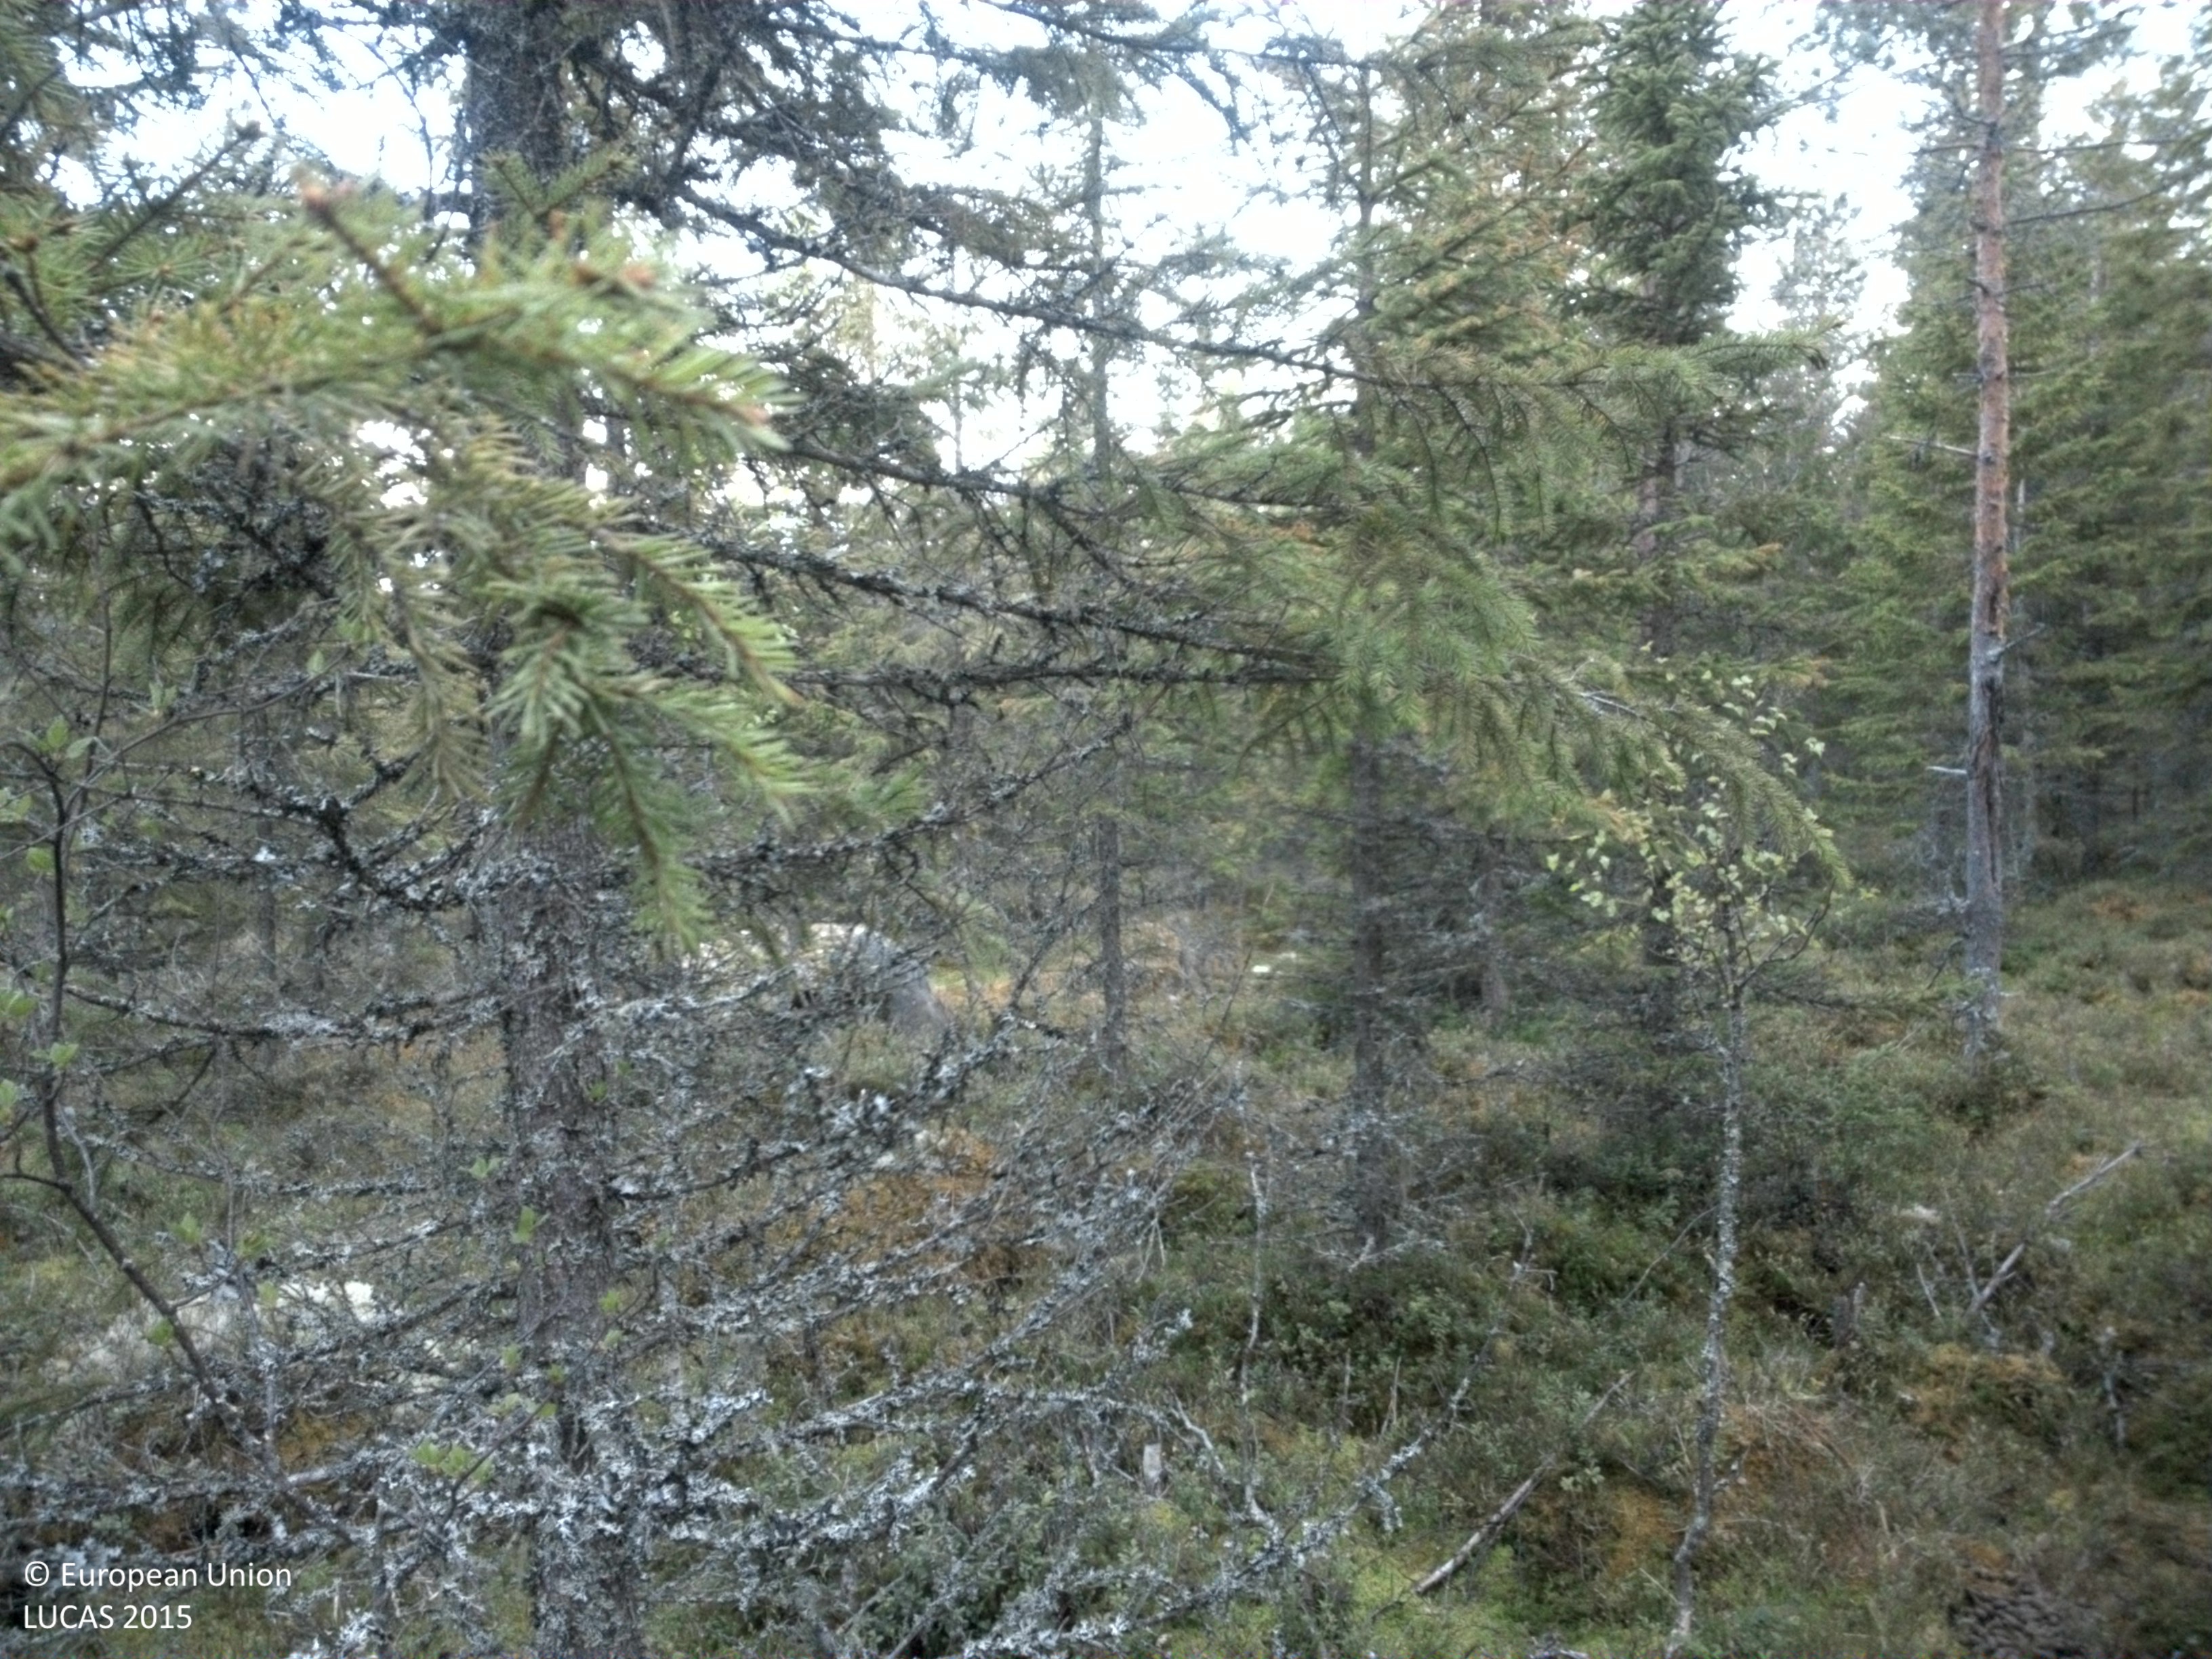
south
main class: Woodland
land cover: Spruce dominated coniferous woodland
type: boreal forest
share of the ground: > 75 %
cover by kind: coniferous forest trees 80 %, shrubs 20 %
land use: Forestry
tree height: > 5 m
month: May
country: SE
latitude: 60.9346
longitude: 12.4089
